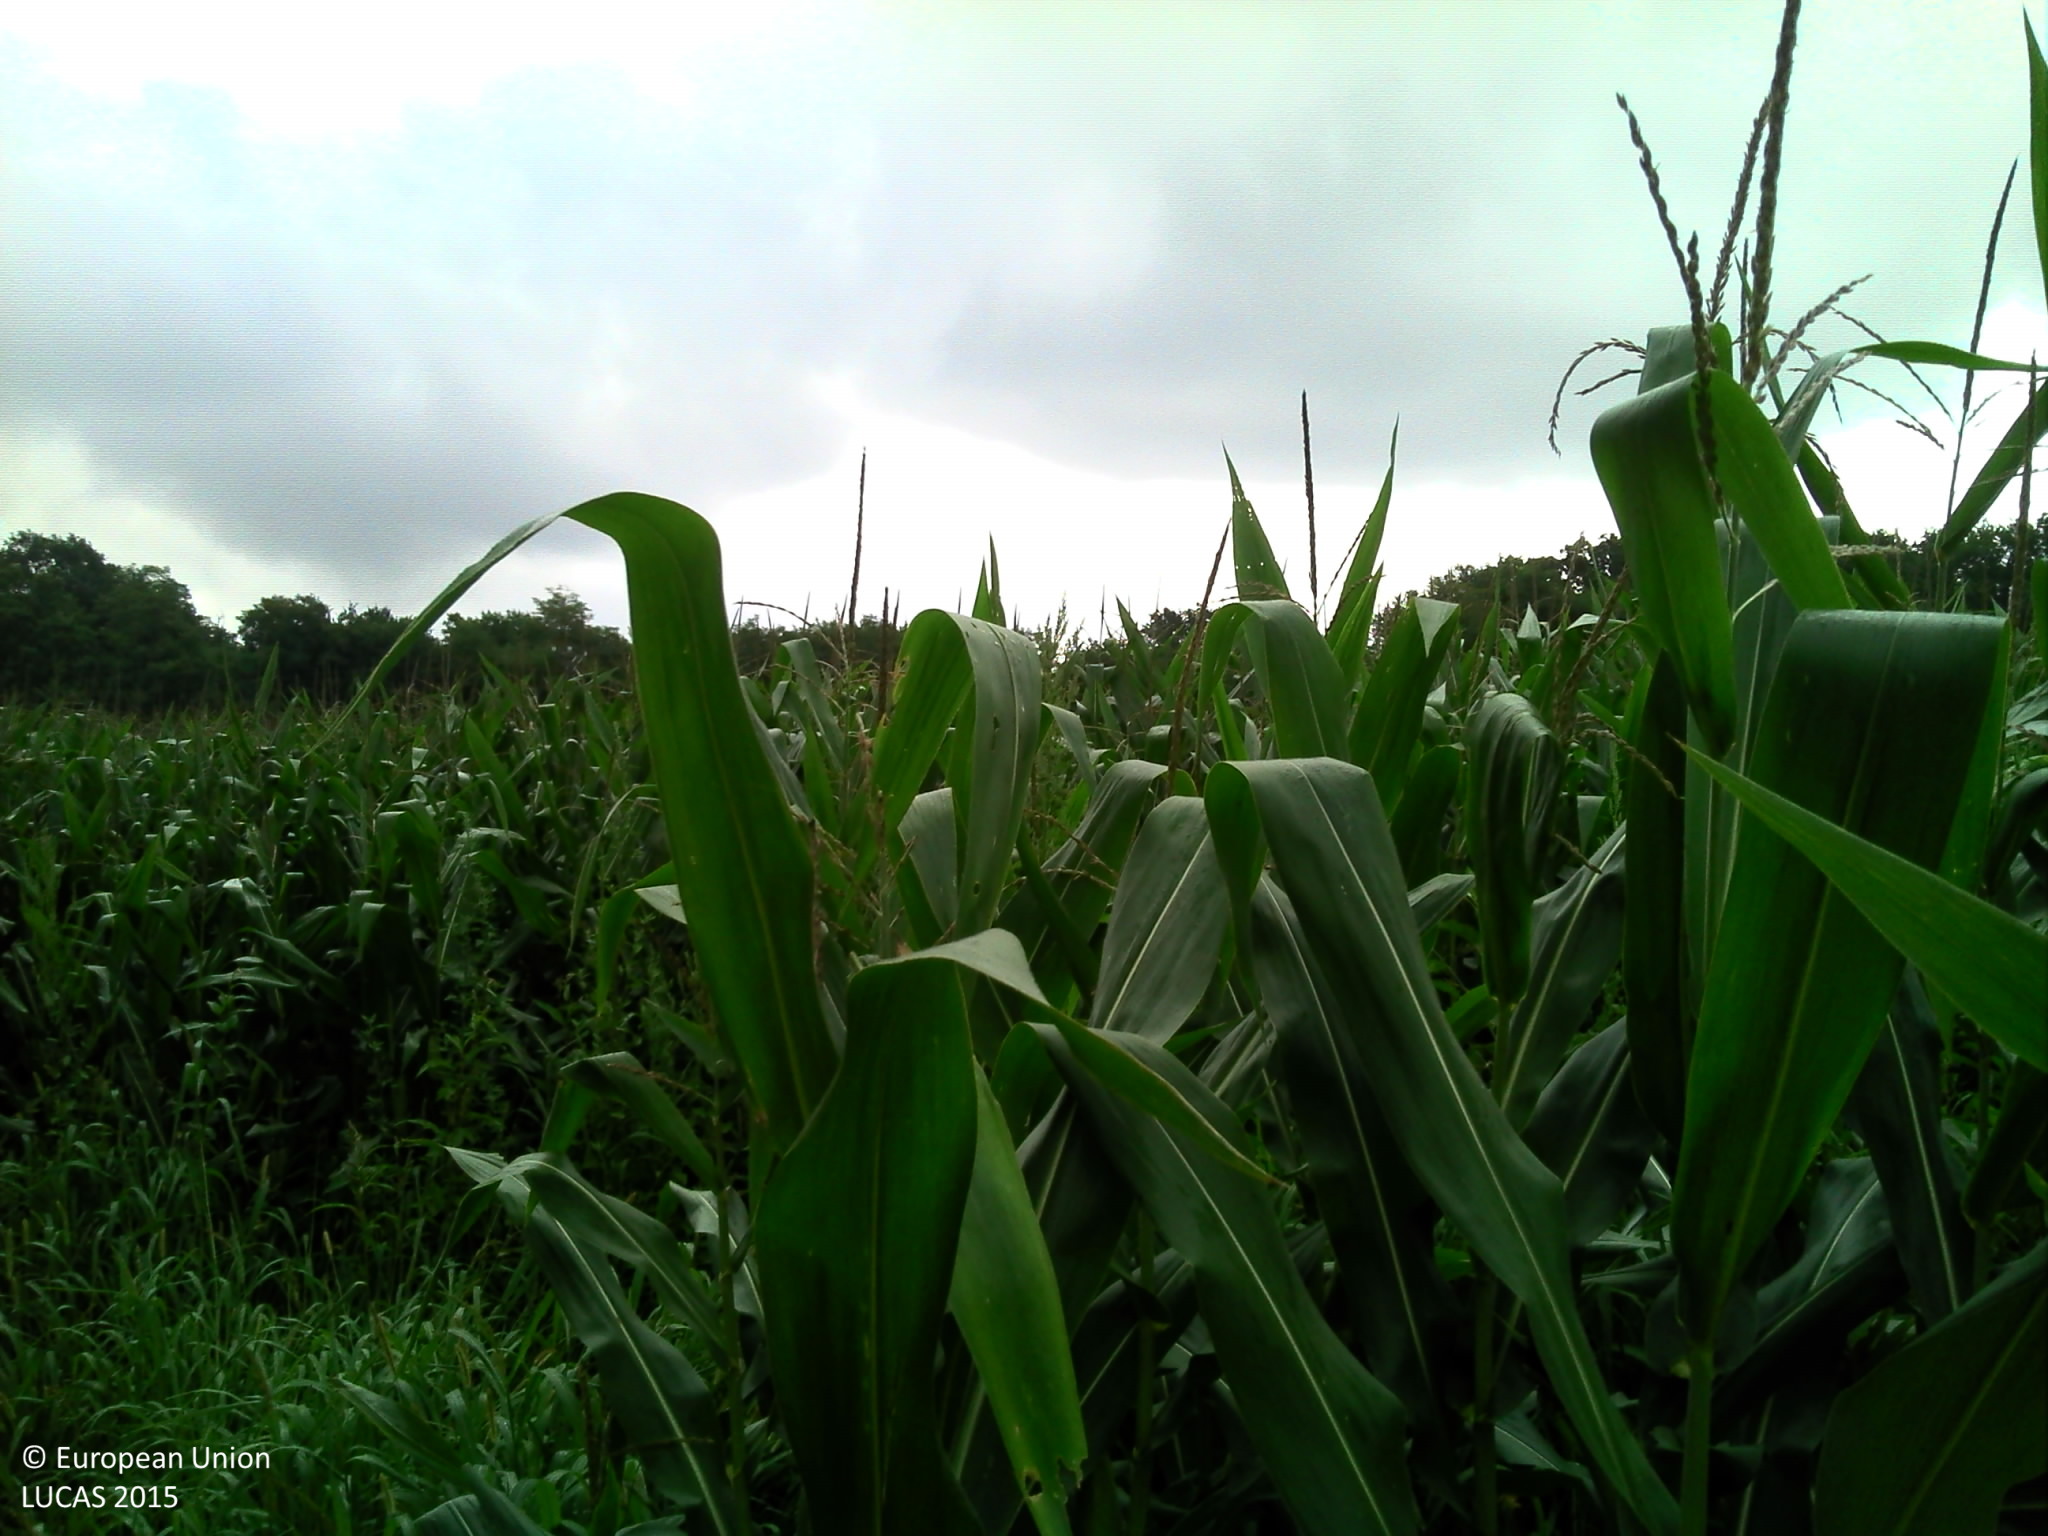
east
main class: Cropland
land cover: Maize
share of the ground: > 75 %
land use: Agriculture (excluding fallow land and kitchen gardens)
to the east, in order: Maize; Electric lines; Maize; Paved roads, cycling and walking lanes; Broadleaved woodland; Rivers and streams; Broadleaved woodland; Grassland without tree/shrub cover; Arable land (only in case pi)
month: August
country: FR
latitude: 43.6561
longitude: -0.9882
